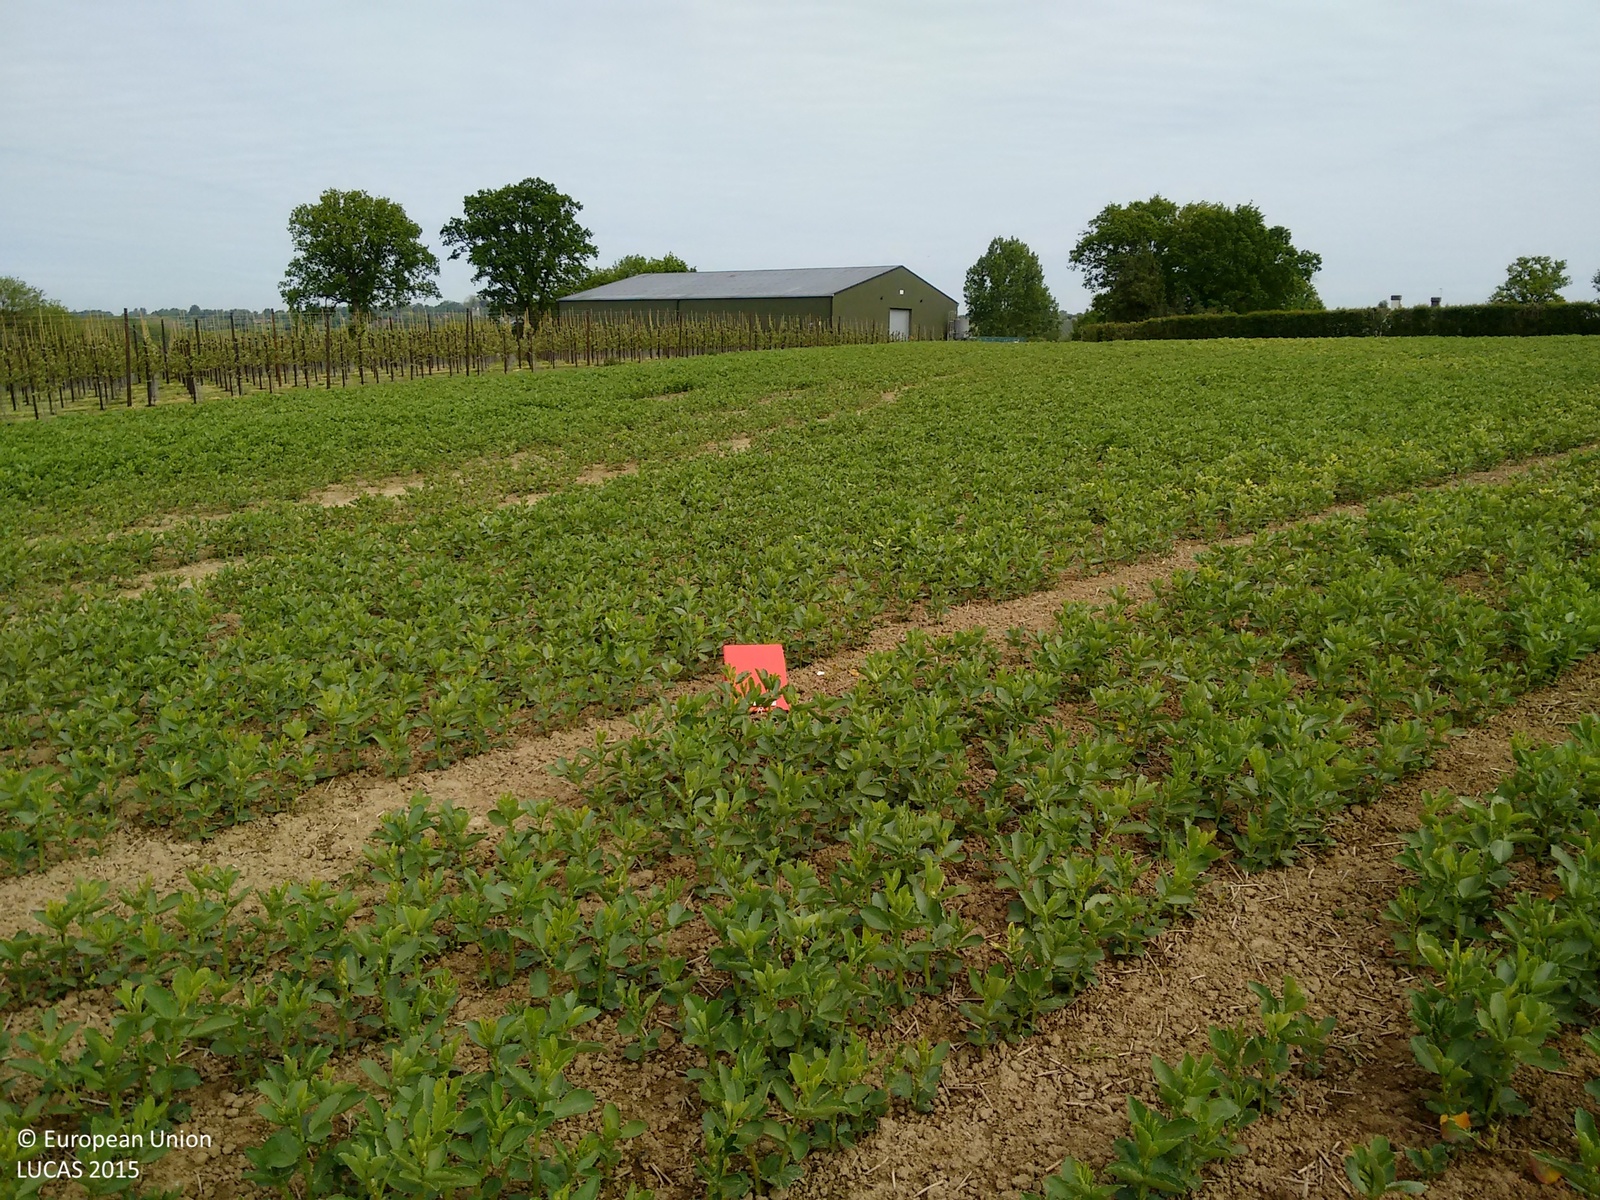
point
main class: Cropland
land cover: Dry pulses
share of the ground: > 75 %
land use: Agriculture (excluding fallow land and kitchen gardens)
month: May
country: GB
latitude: 51.1373
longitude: 0.4099
